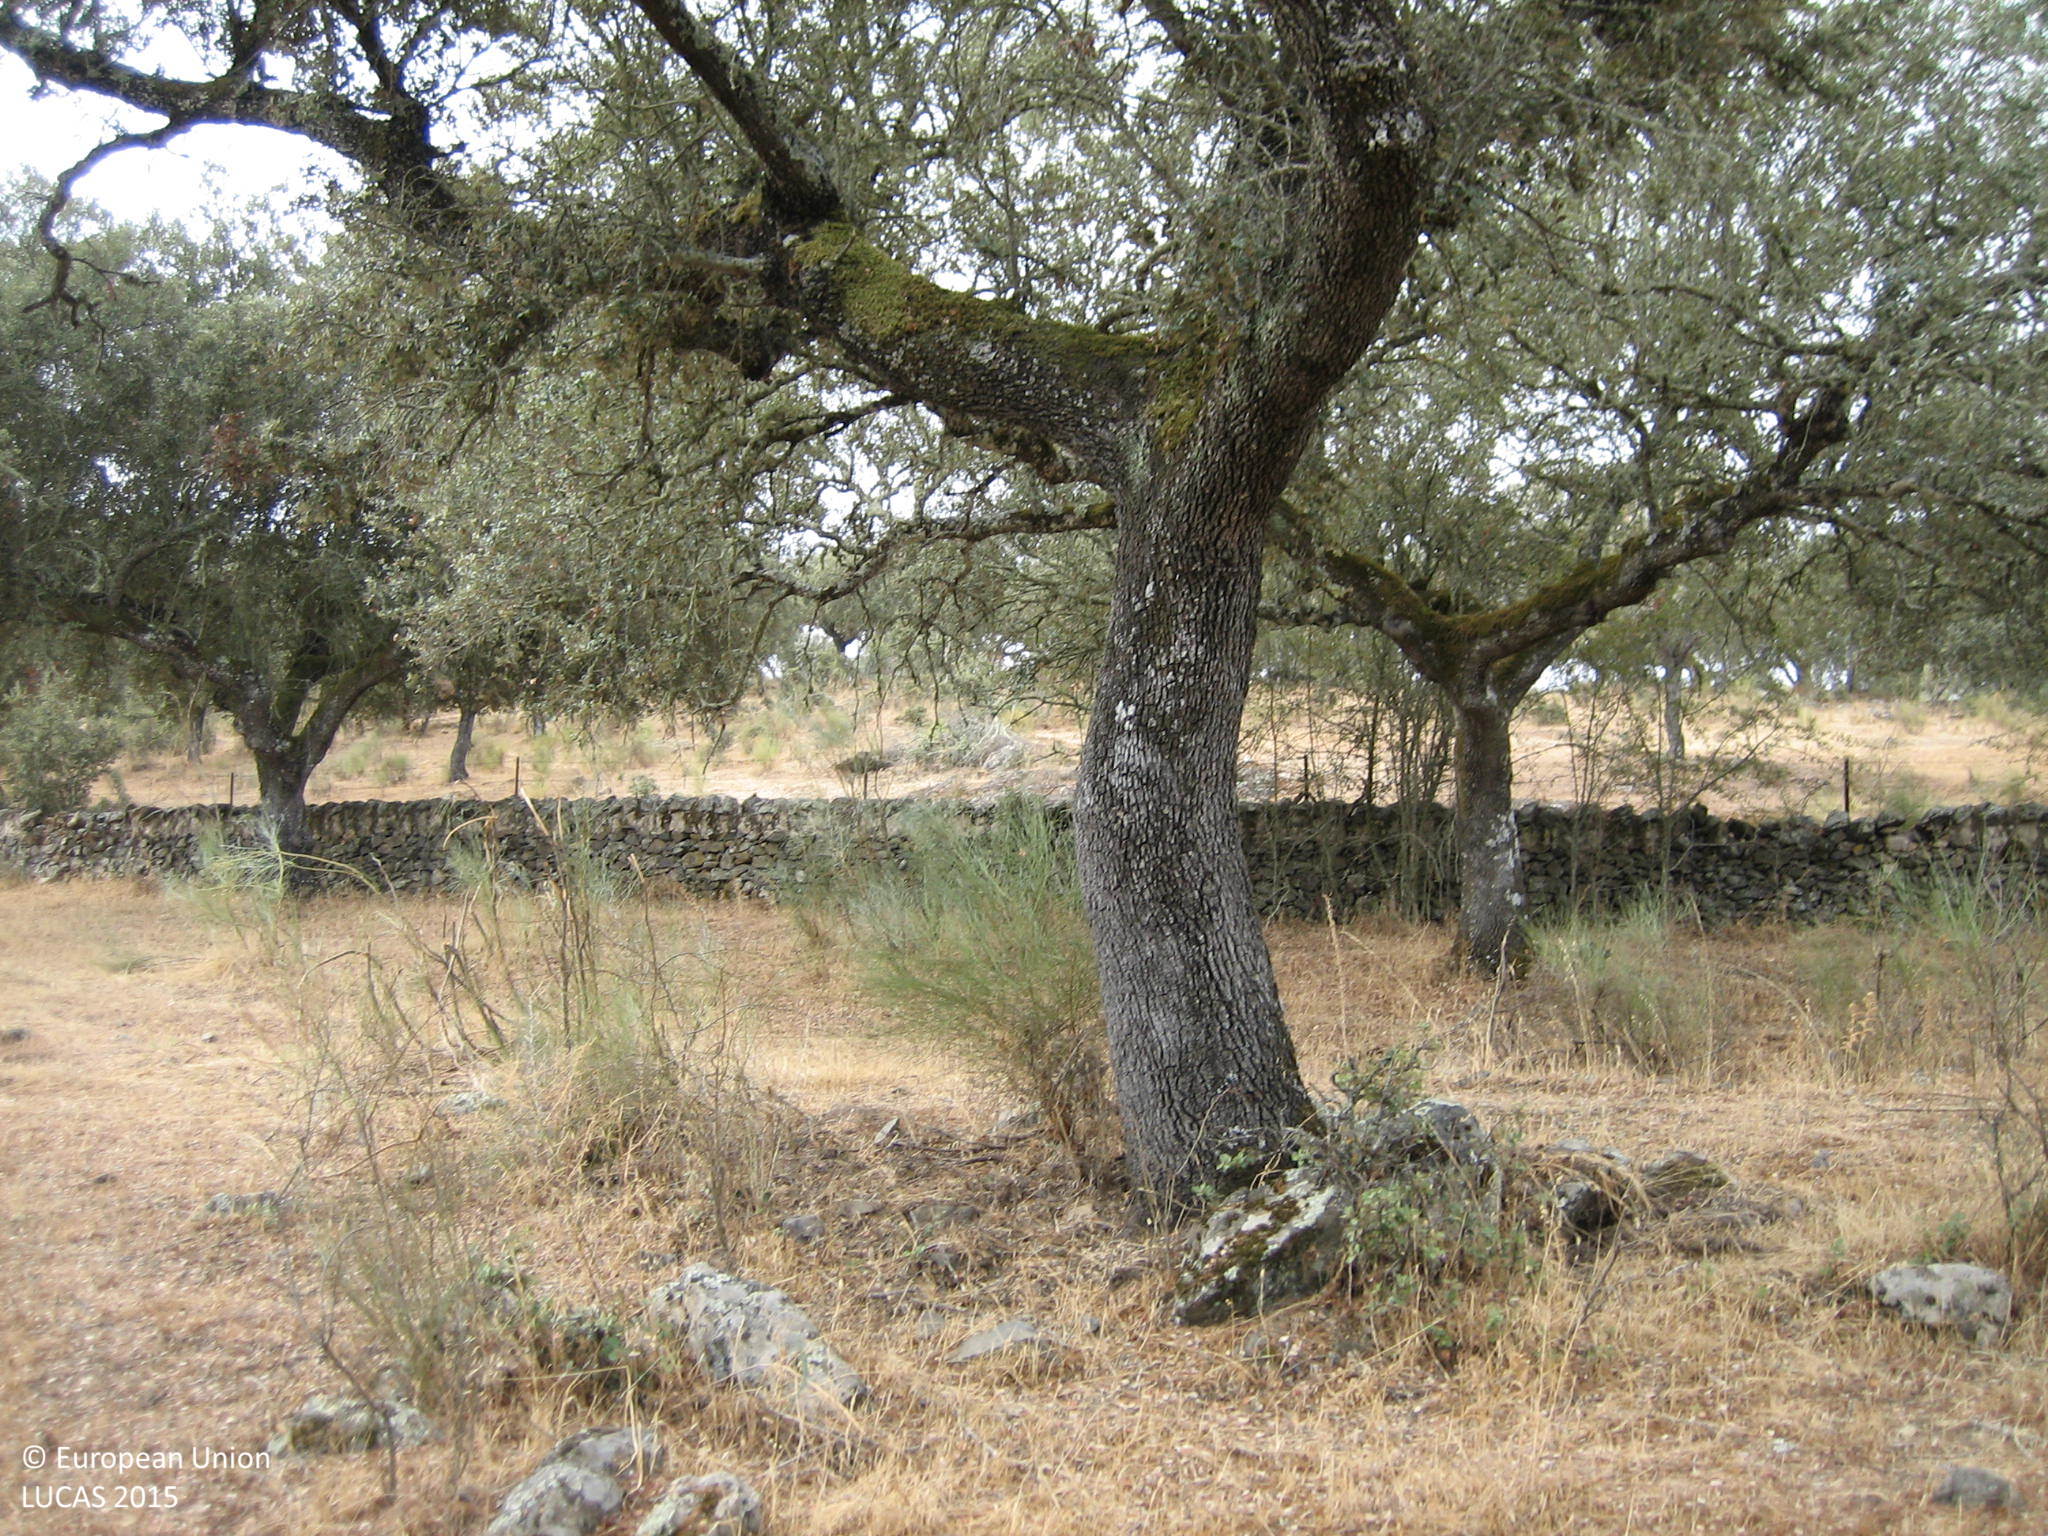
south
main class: Woodland
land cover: Broadleaved woodland
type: broadleaved evergreen forest
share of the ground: 25 - 50 %
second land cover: Shrubland without tree cover
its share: 10 - 25 %
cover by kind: herbaceous plants 55 %, broadleaved forest trees 30 %, shrubs 15 %
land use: Forestry
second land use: Agriculture (excluding fallow land and kitchen gardens)
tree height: > 5 m
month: September
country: ES
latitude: 38.5639
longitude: -6.9221
